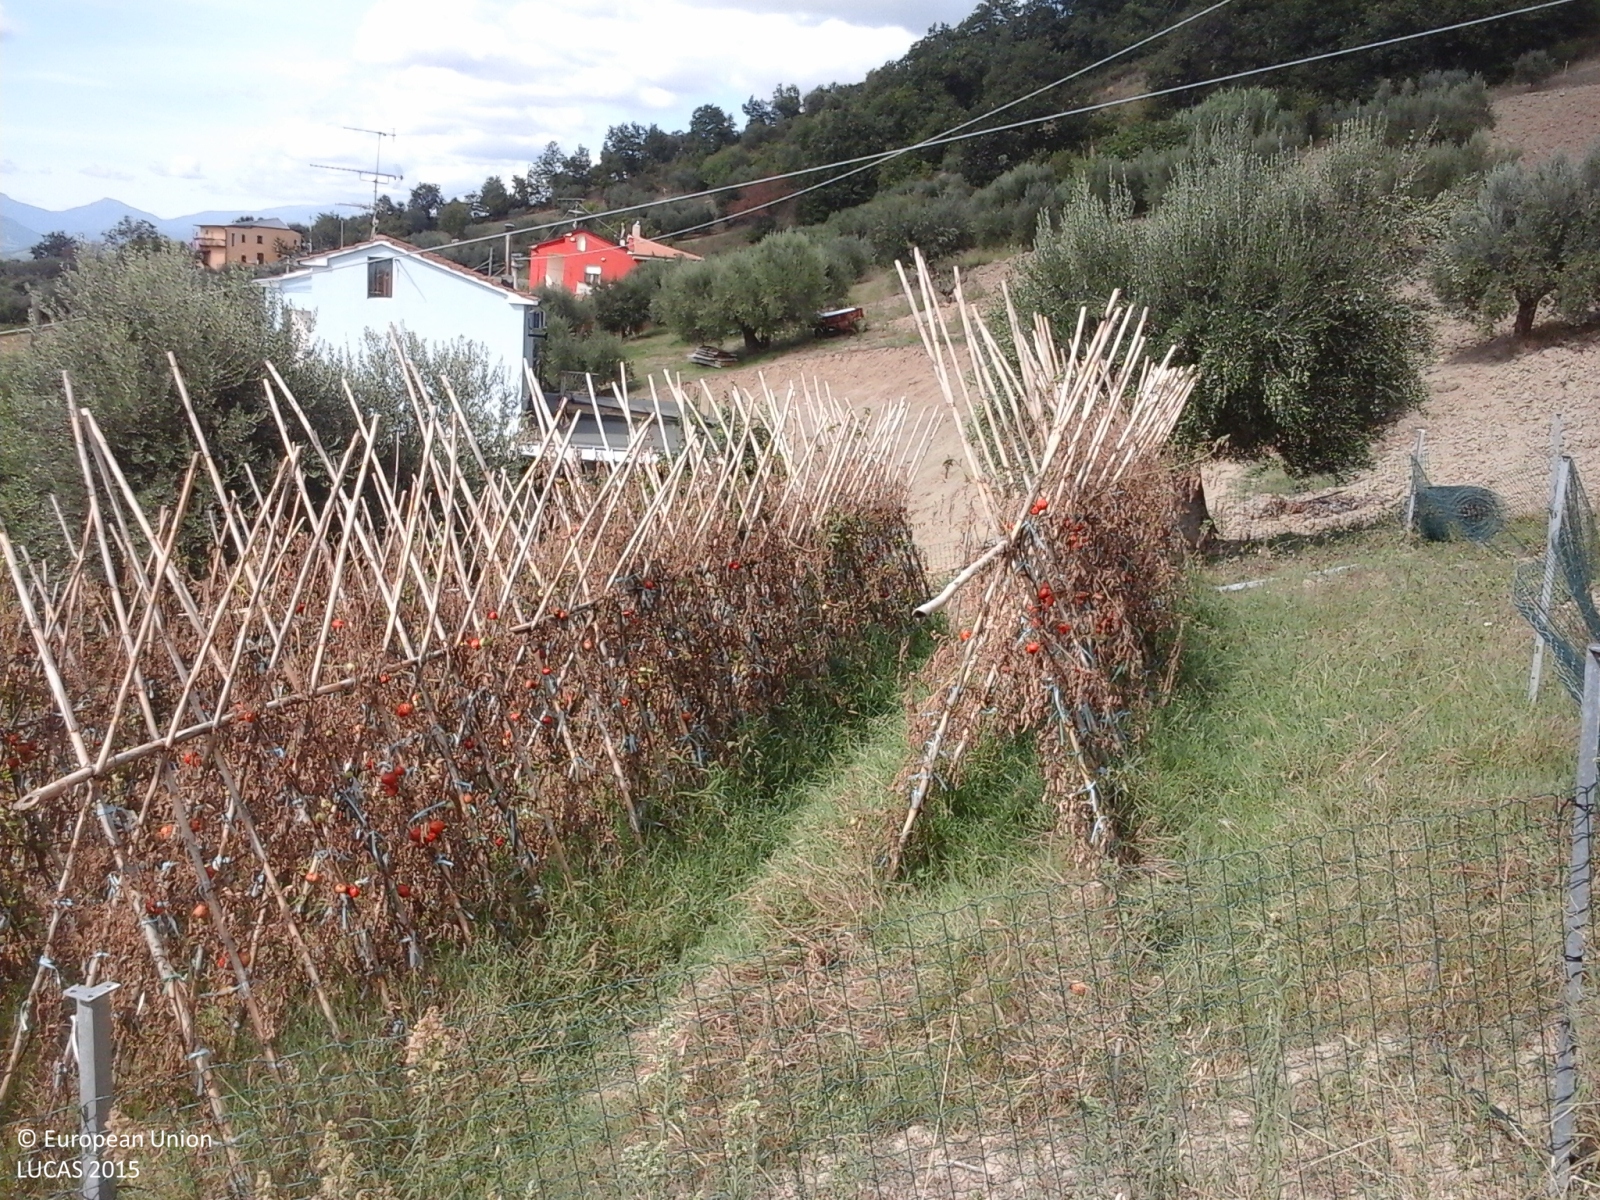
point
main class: Cropland
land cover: Olive groves
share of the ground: 10 - 25 %
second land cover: Tomatoes
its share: 50 - 75 %
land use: Agriculture (excluding fallow land and kitchen gardens)
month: September
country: IT
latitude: 42.6368
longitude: 13.8059
